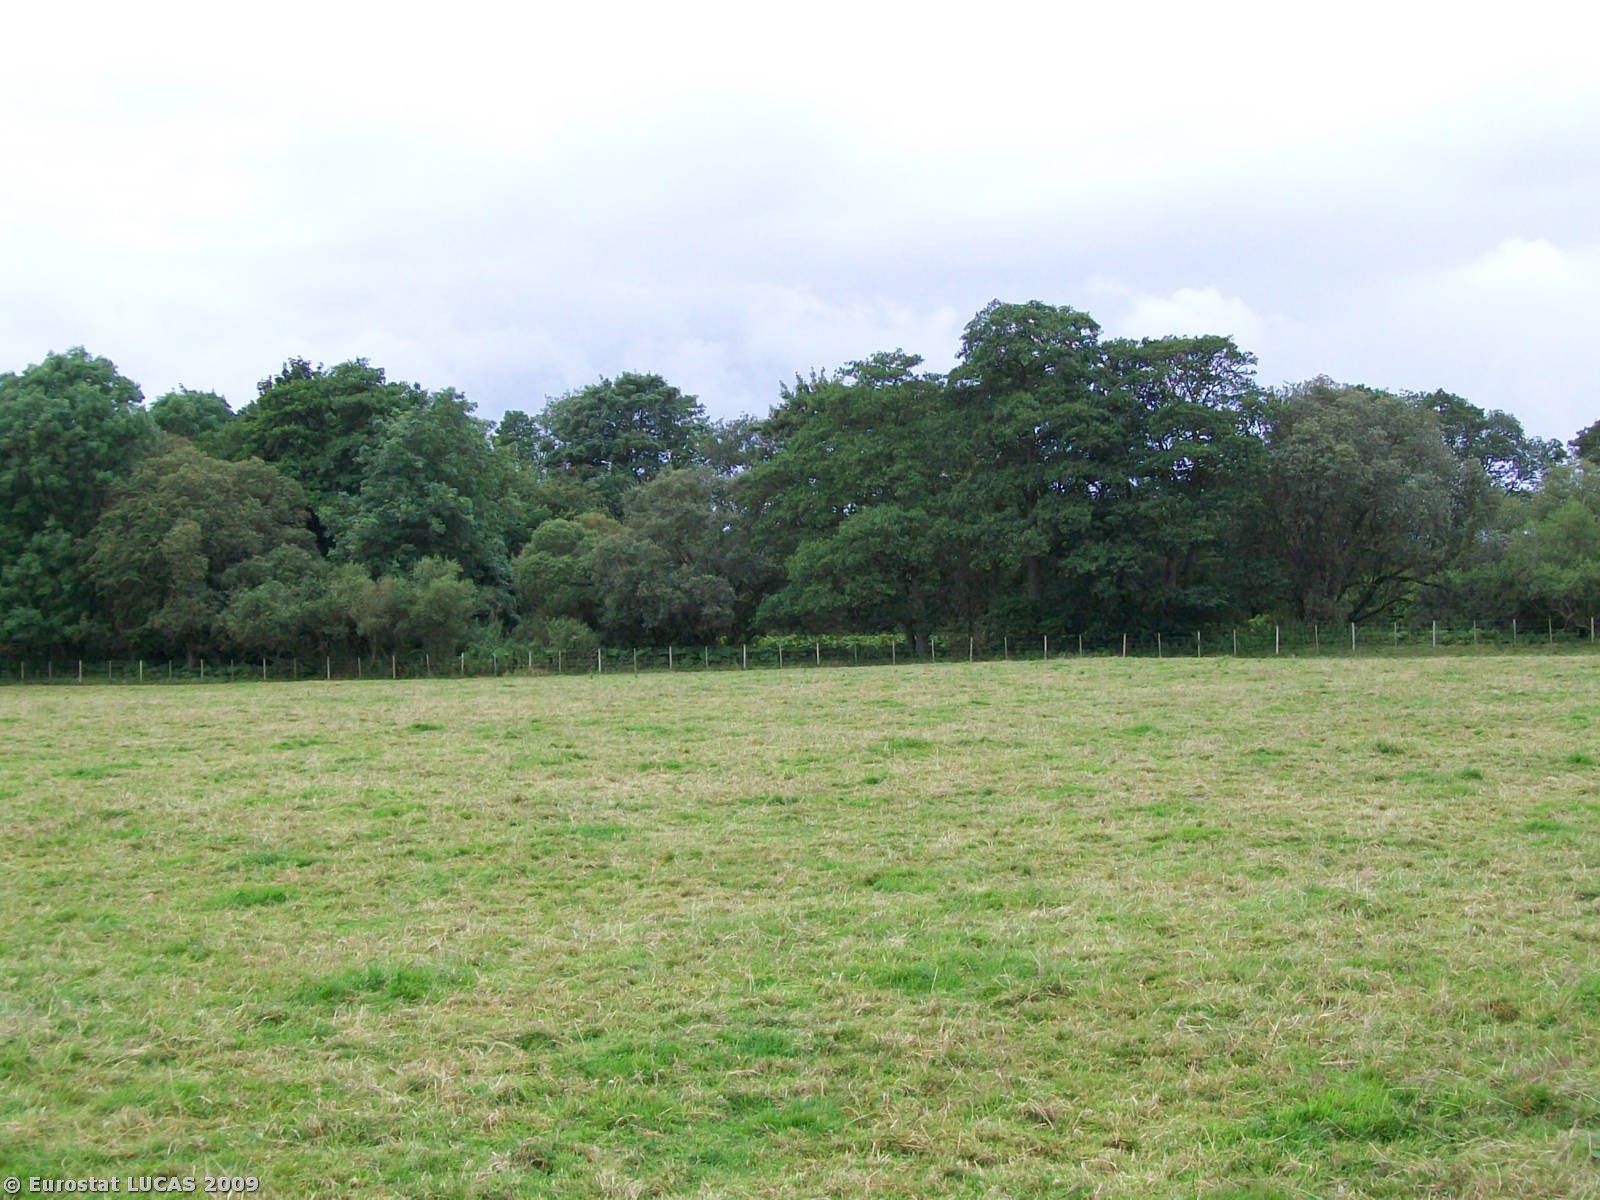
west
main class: Grassland
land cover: Grassland without tree/shrub cover
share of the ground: > 75 %
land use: Agriculture (excluding fallow land and kitchen gardens)
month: July
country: GB
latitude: 55.0496
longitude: -3.3348
